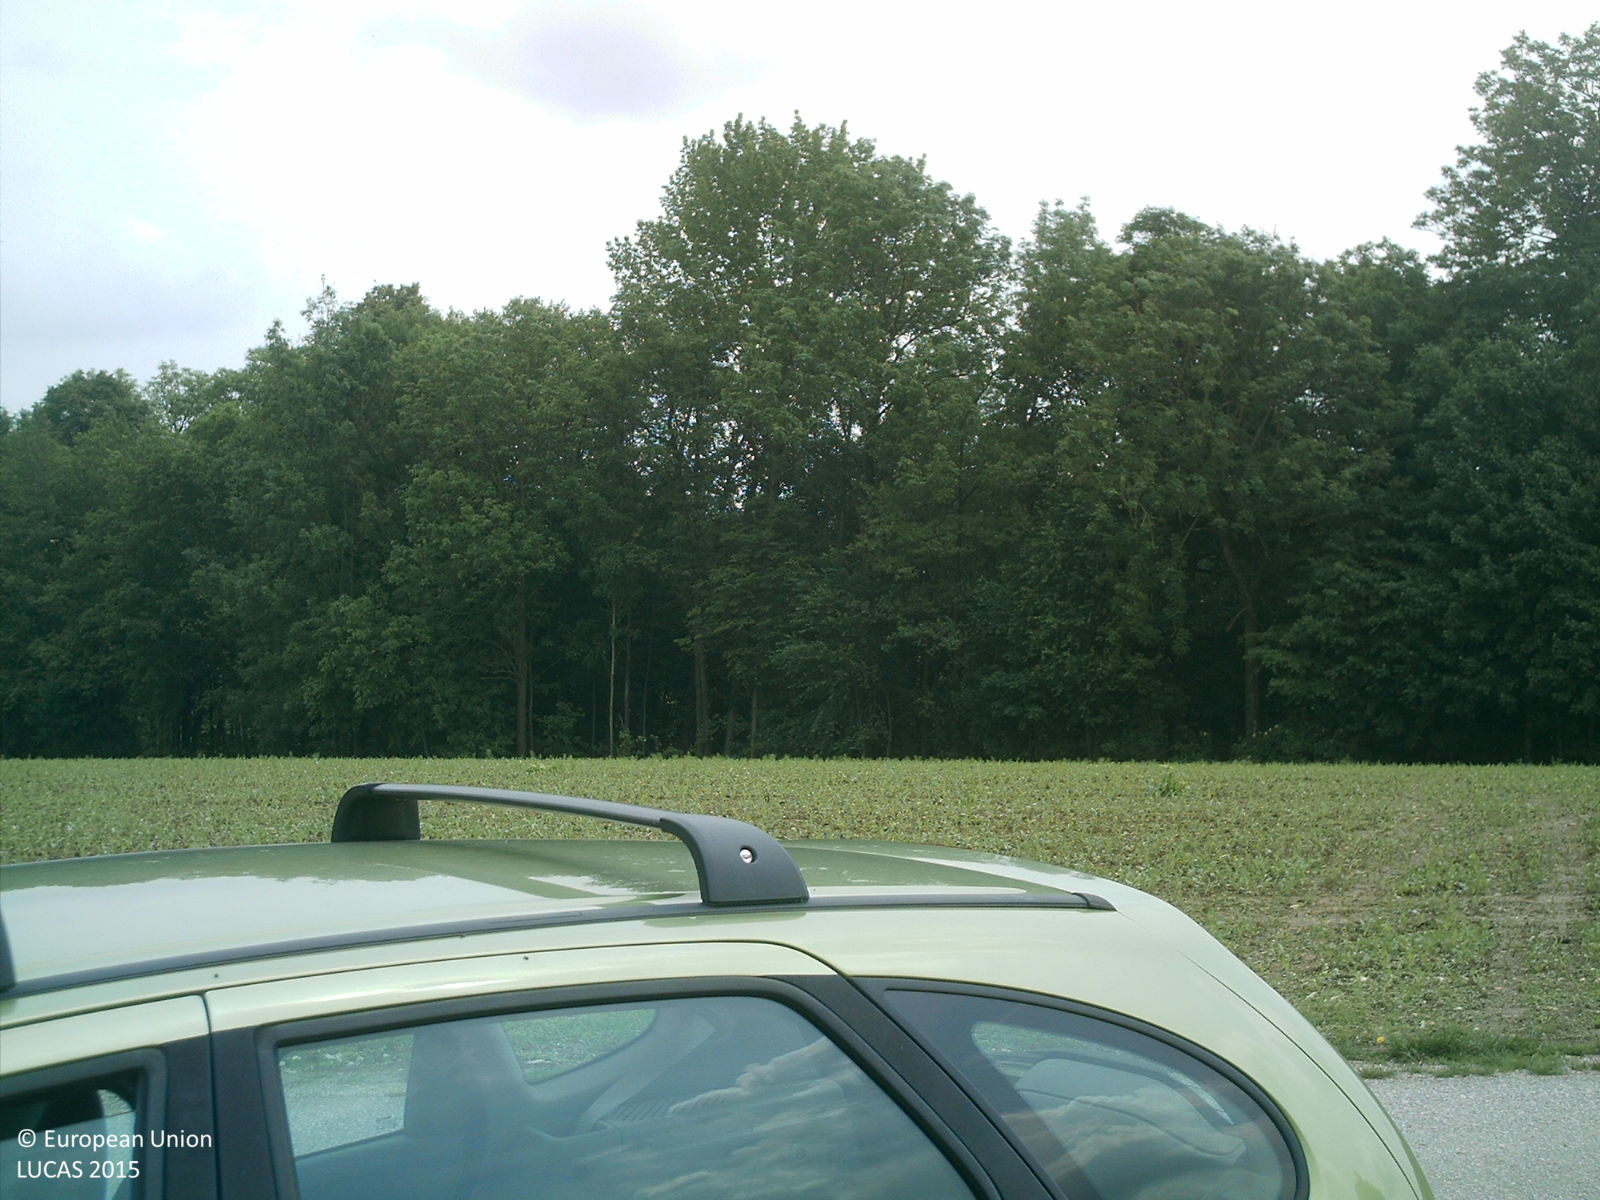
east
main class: Cropland
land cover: Common wheat
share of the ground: > 75 %
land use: Agriculture (excluding fallow land and kitchen gardens)
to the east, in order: Common wheat; Grass margins; Tracks; Grassland without tree/shrub cover; Paved roads, cycling and walking lanes; Grass margins; Maize; Spontaneously vegetated surfaces; Broadleaved woodland; Rivers and streams; Broadleaved woodland; Spontaneously vegetated surfaces; Barley
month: May
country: AT
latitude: 48.0735
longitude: 14.1470
